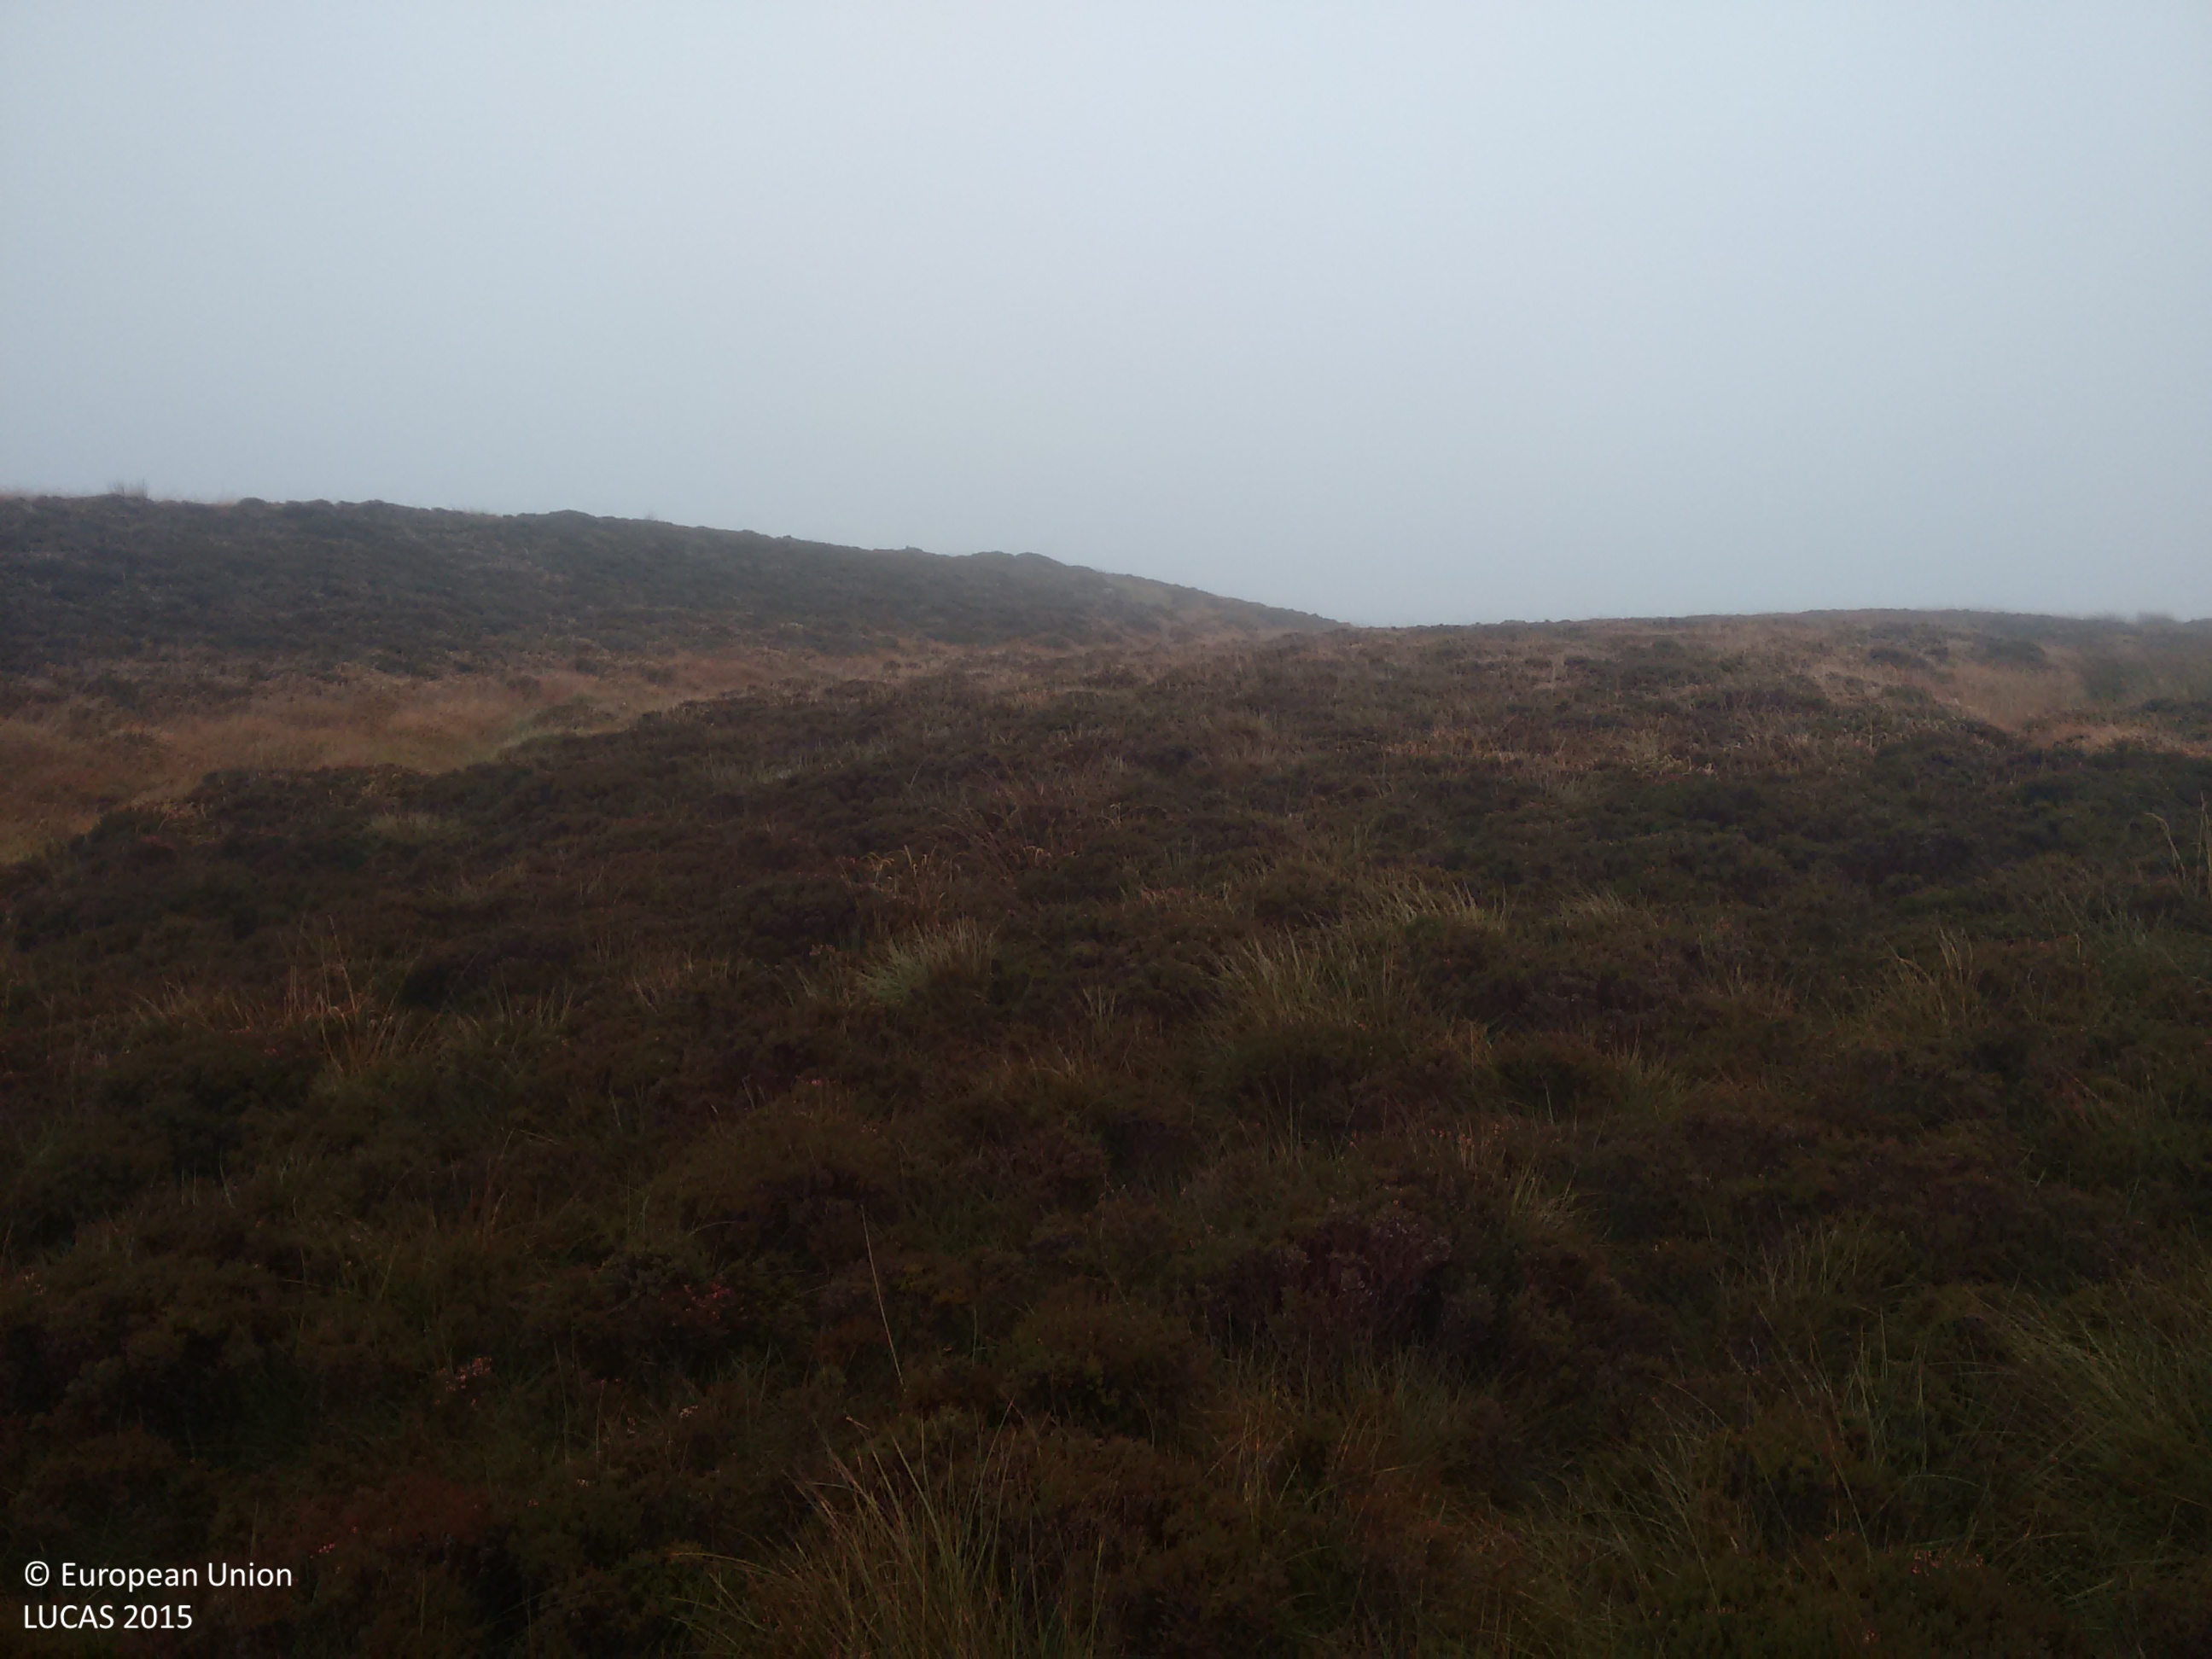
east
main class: Shrubland
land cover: Shrubland without tree cover
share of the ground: > 75 %
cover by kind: shrubs 90 %, herbaceous plants 5 %, lichens and mosses 5 %
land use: Agriculture (excluding fallow land and kitchen gardens)
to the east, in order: Shrubland without tree cover; Inland marshes; Shrubland without tree cover
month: October
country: GB
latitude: 55.6140
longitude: -6.2922
